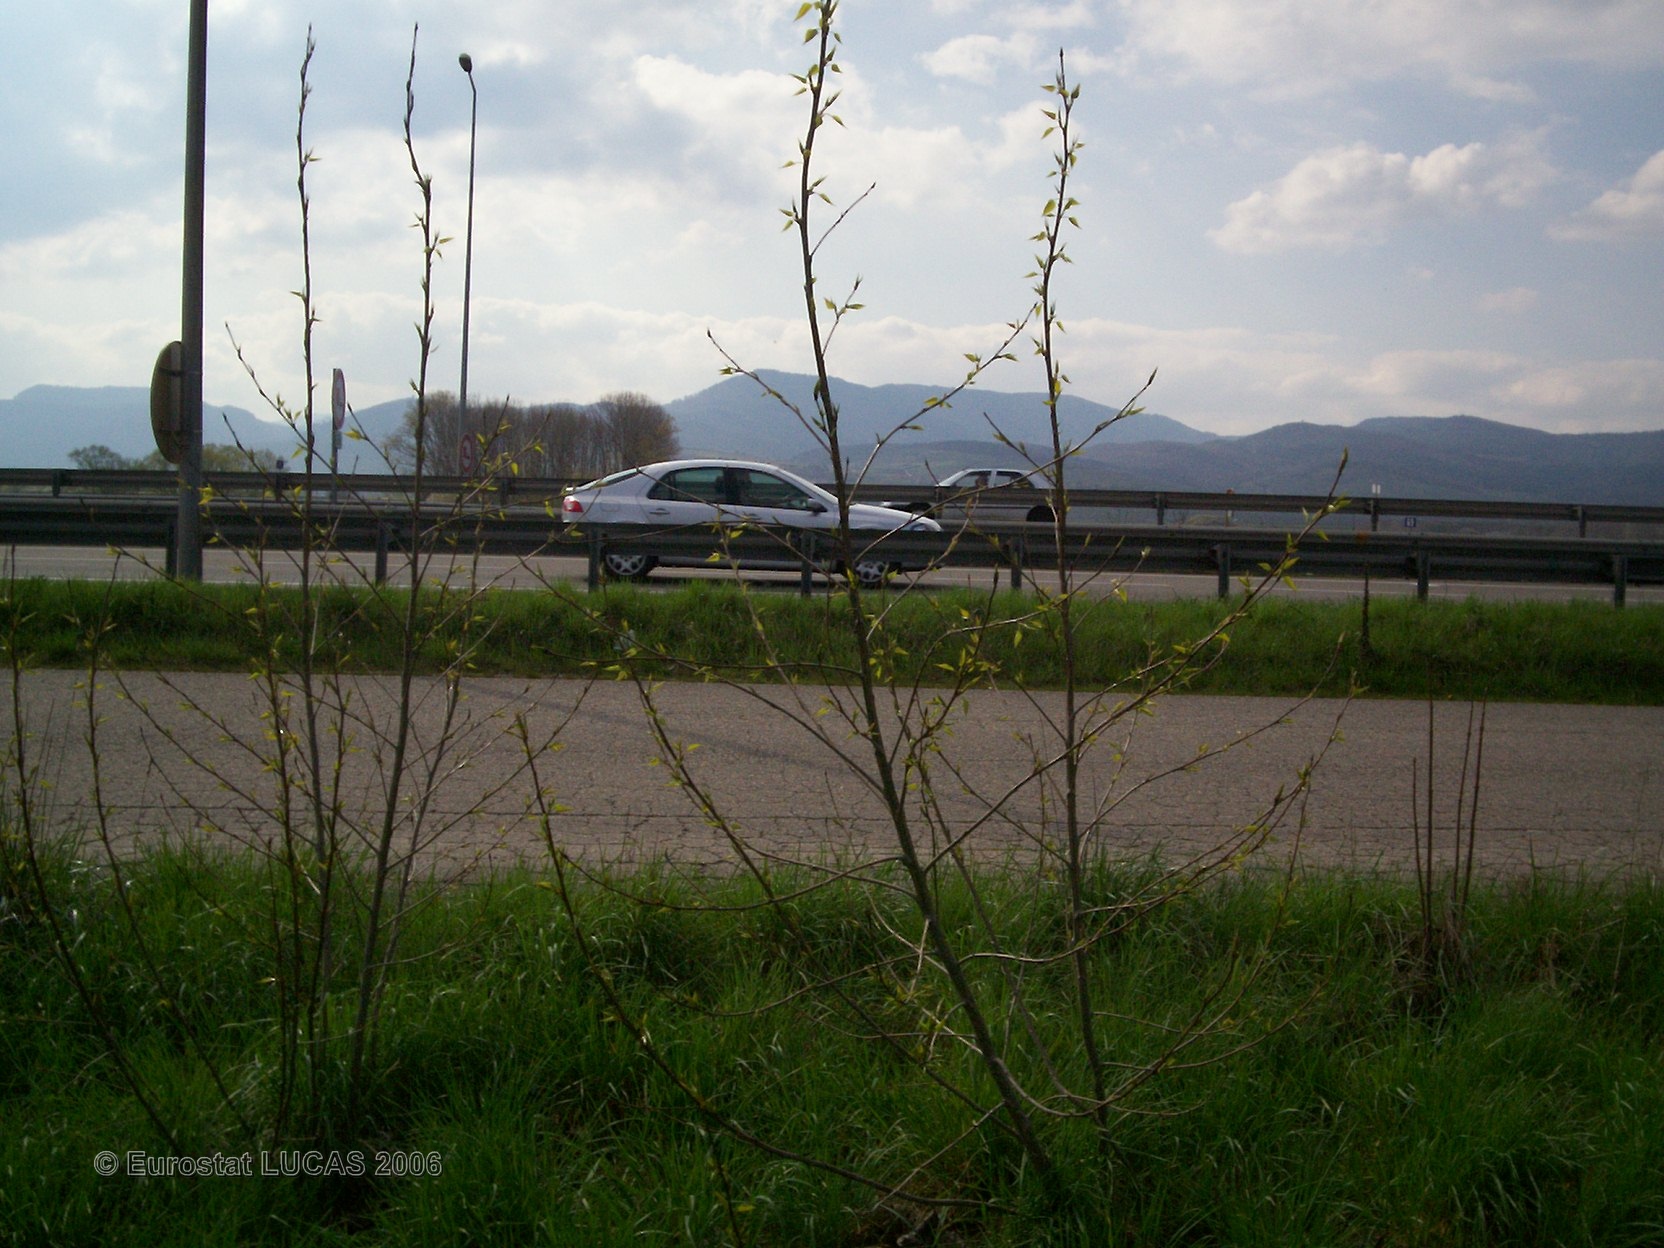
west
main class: Cropland
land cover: Apple fruit
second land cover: Grassland with sparse tree/shrub cover
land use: Agriculture (excluding fallow land and kitchen gardens)
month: April
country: FR
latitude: 48.2110
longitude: 7.4038
